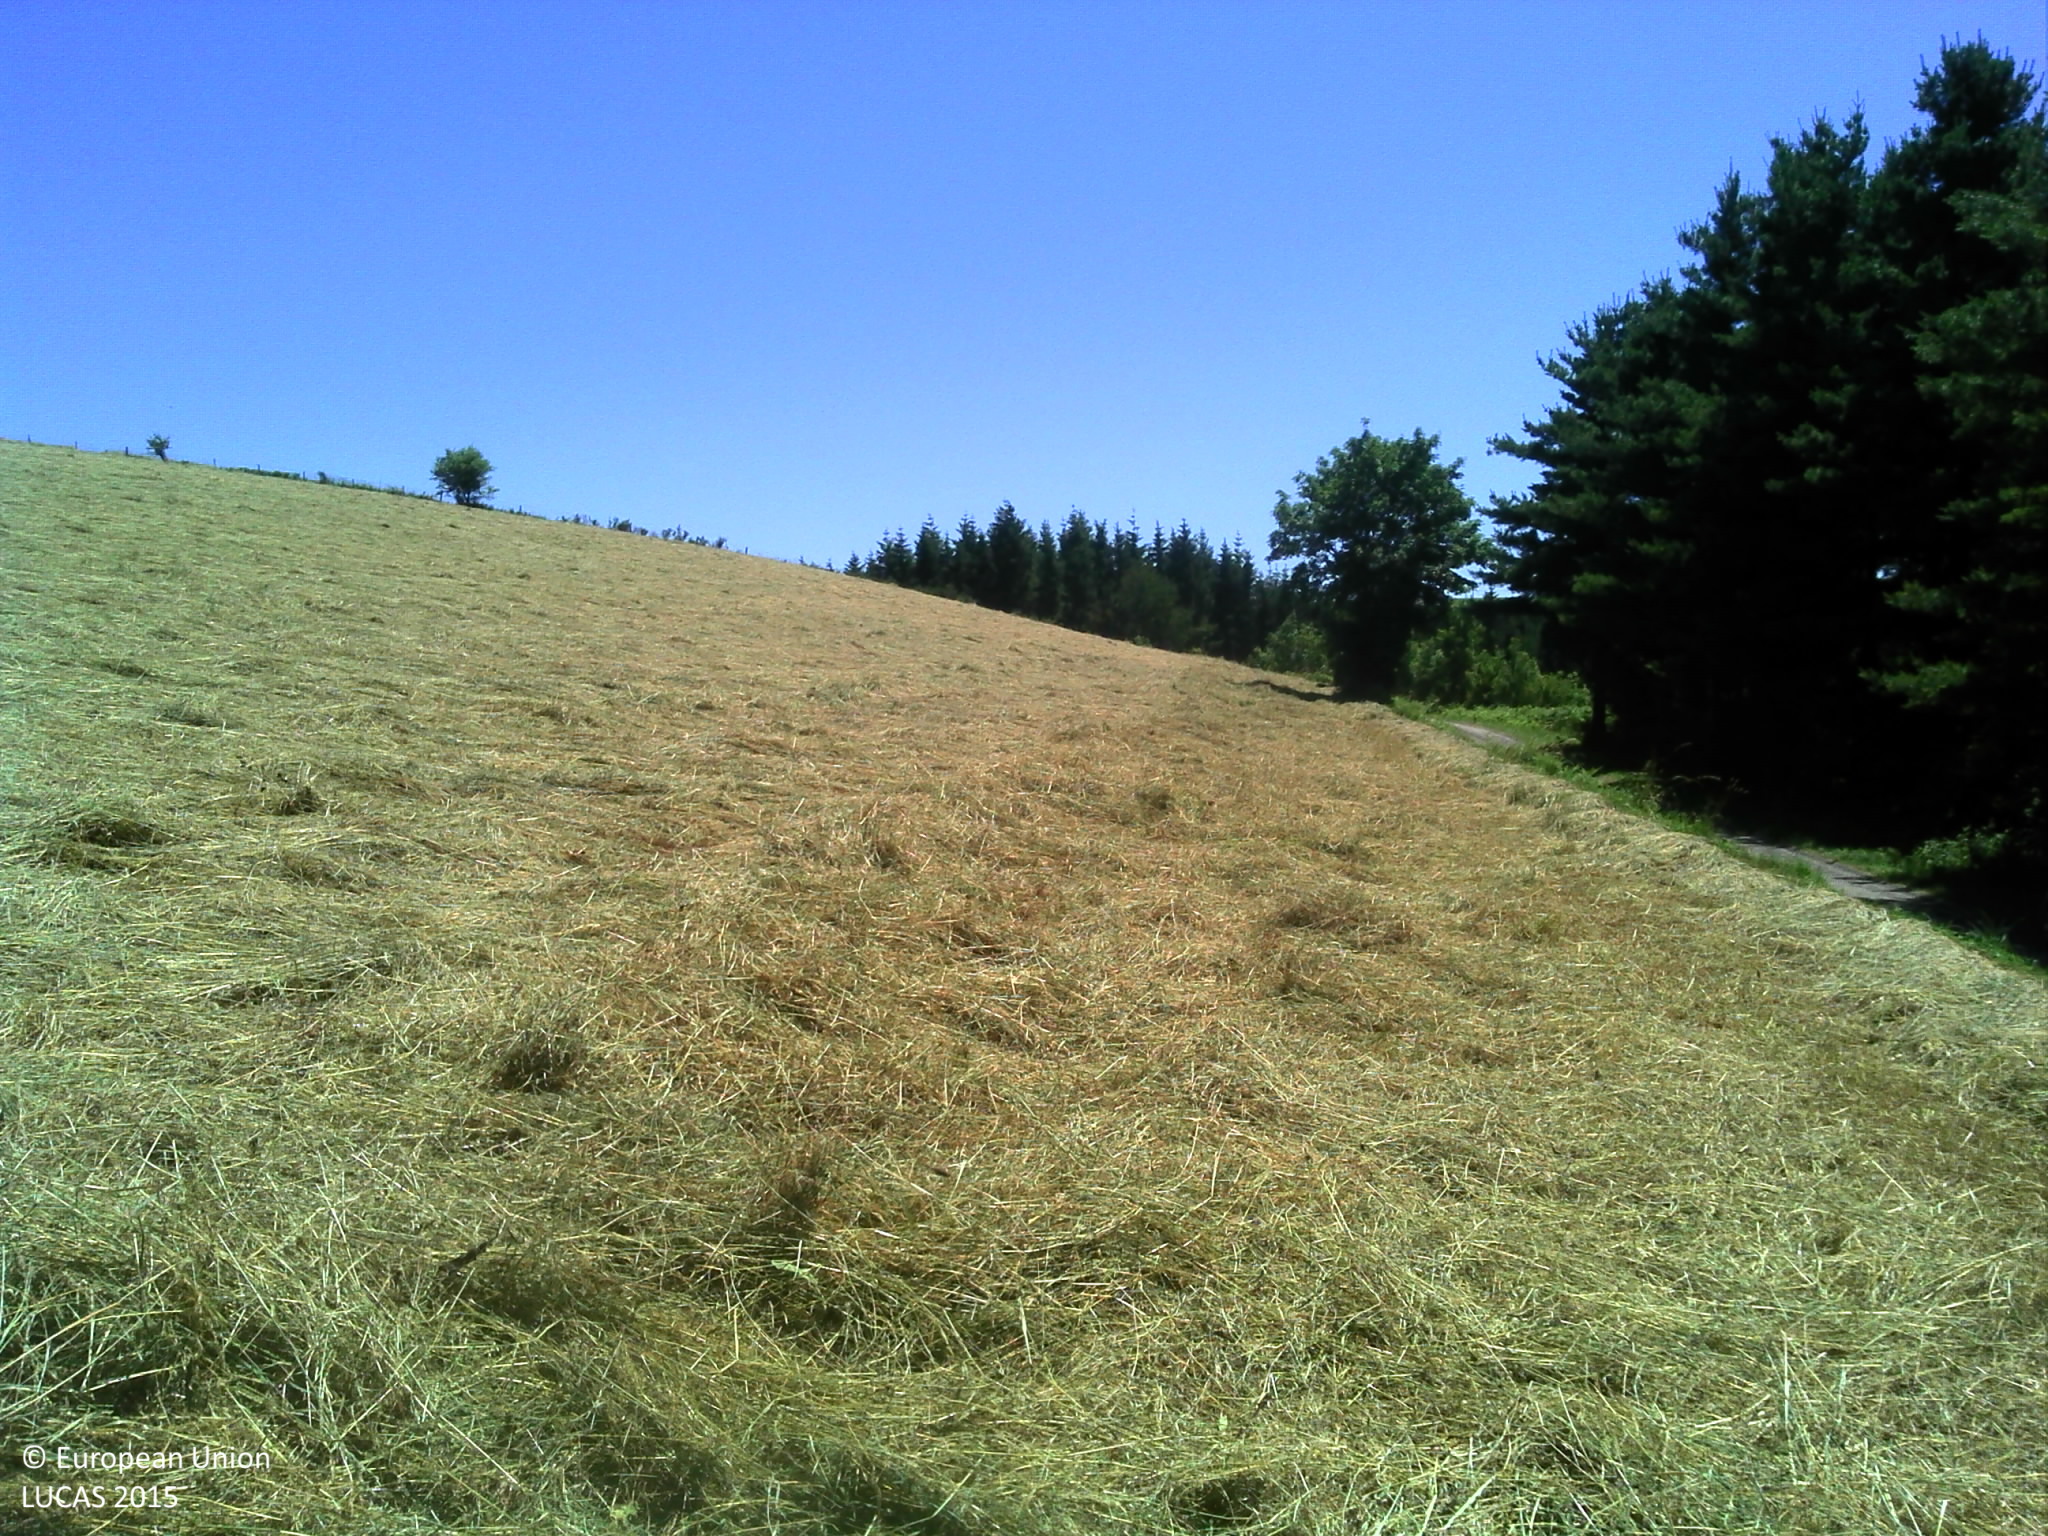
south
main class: Grassland
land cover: Grassland without tree/shrub cover
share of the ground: > 75 %
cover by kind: herbaceous plants 100 %
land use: Agriculture (excluding fallow land and kitchen gardens)
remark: Harvested field
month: June
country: FR
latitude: 43.7451
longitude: 2.6425
